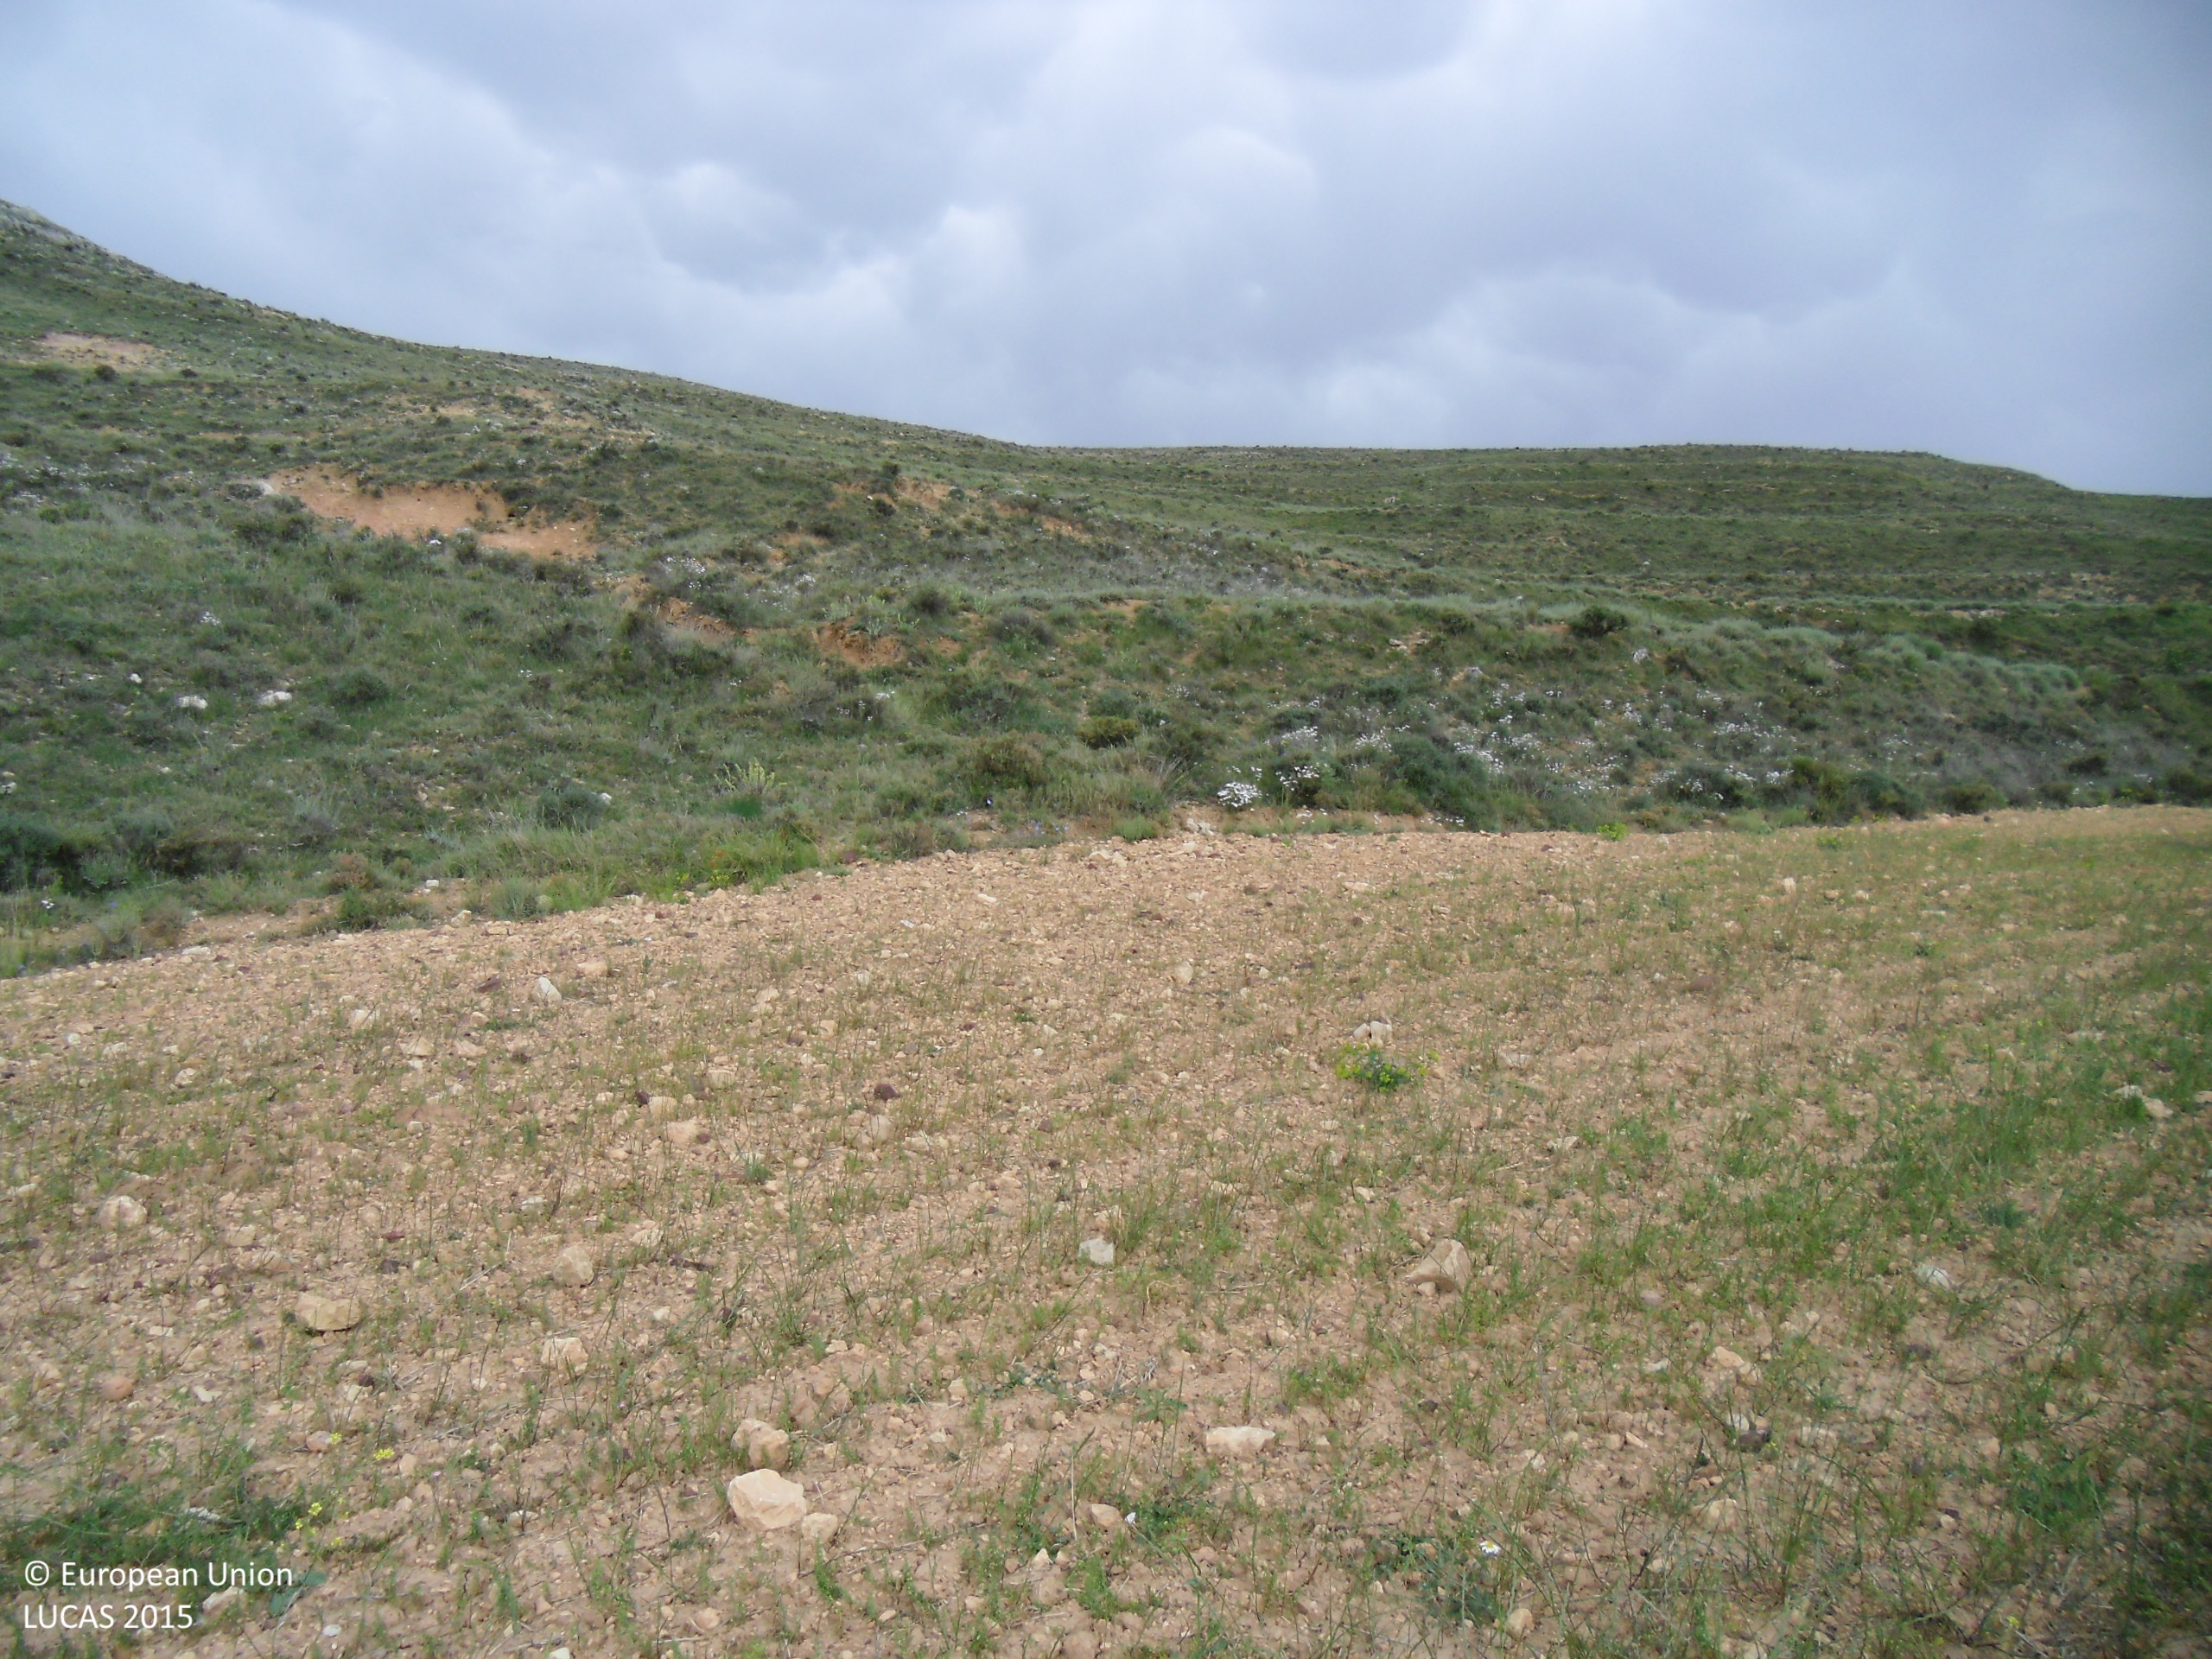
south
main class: Grassland
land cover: Spontaneously vegetated surfaces
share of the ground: 25 - 50 %
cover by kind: unconsolidated bare surface 60 %, herbaceous plants 40 %
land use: Fallow land
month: May
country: ES
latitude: 40.9953
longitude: -0.8450
